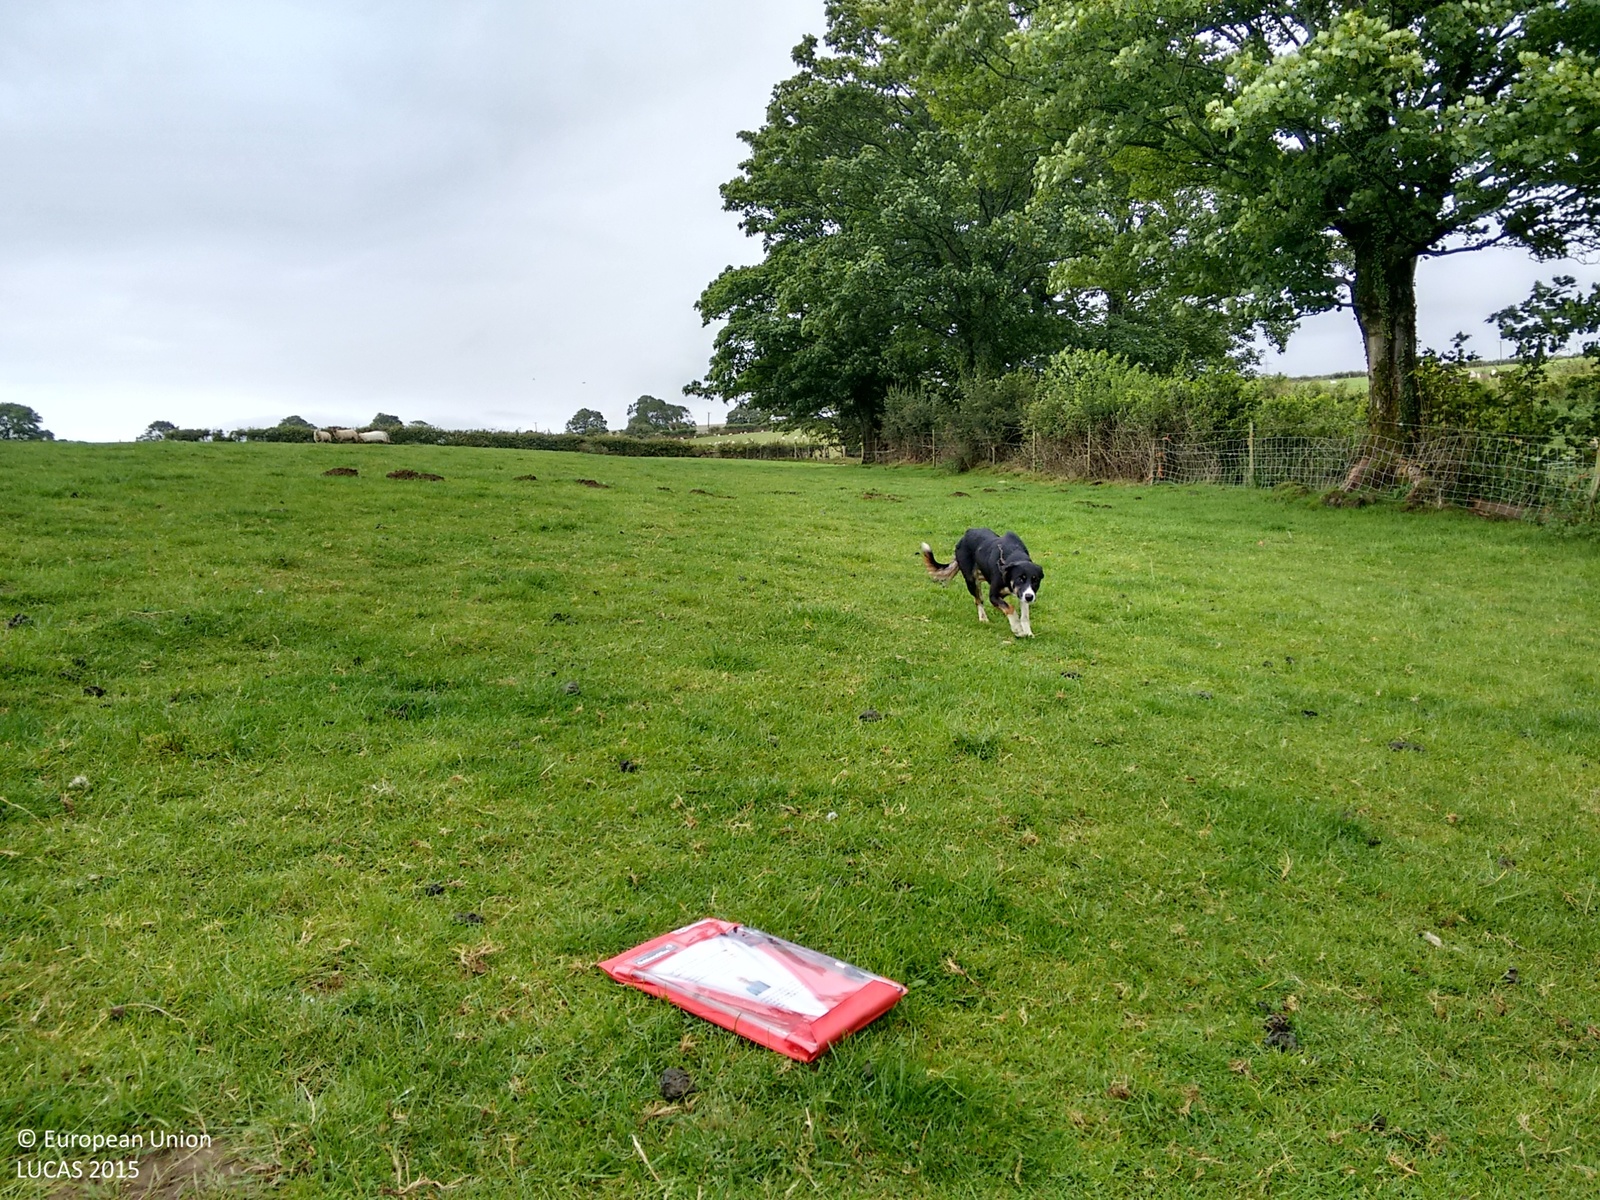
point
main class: Grassland
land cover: Grassland without tree/shrub cover
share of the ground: > 75 %
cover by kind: herbaceous plants 100 %
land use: Agriculture (excluding fallow land and kitchen gardens)
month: July
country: GB
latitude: 51.7133
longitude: -3.9444
